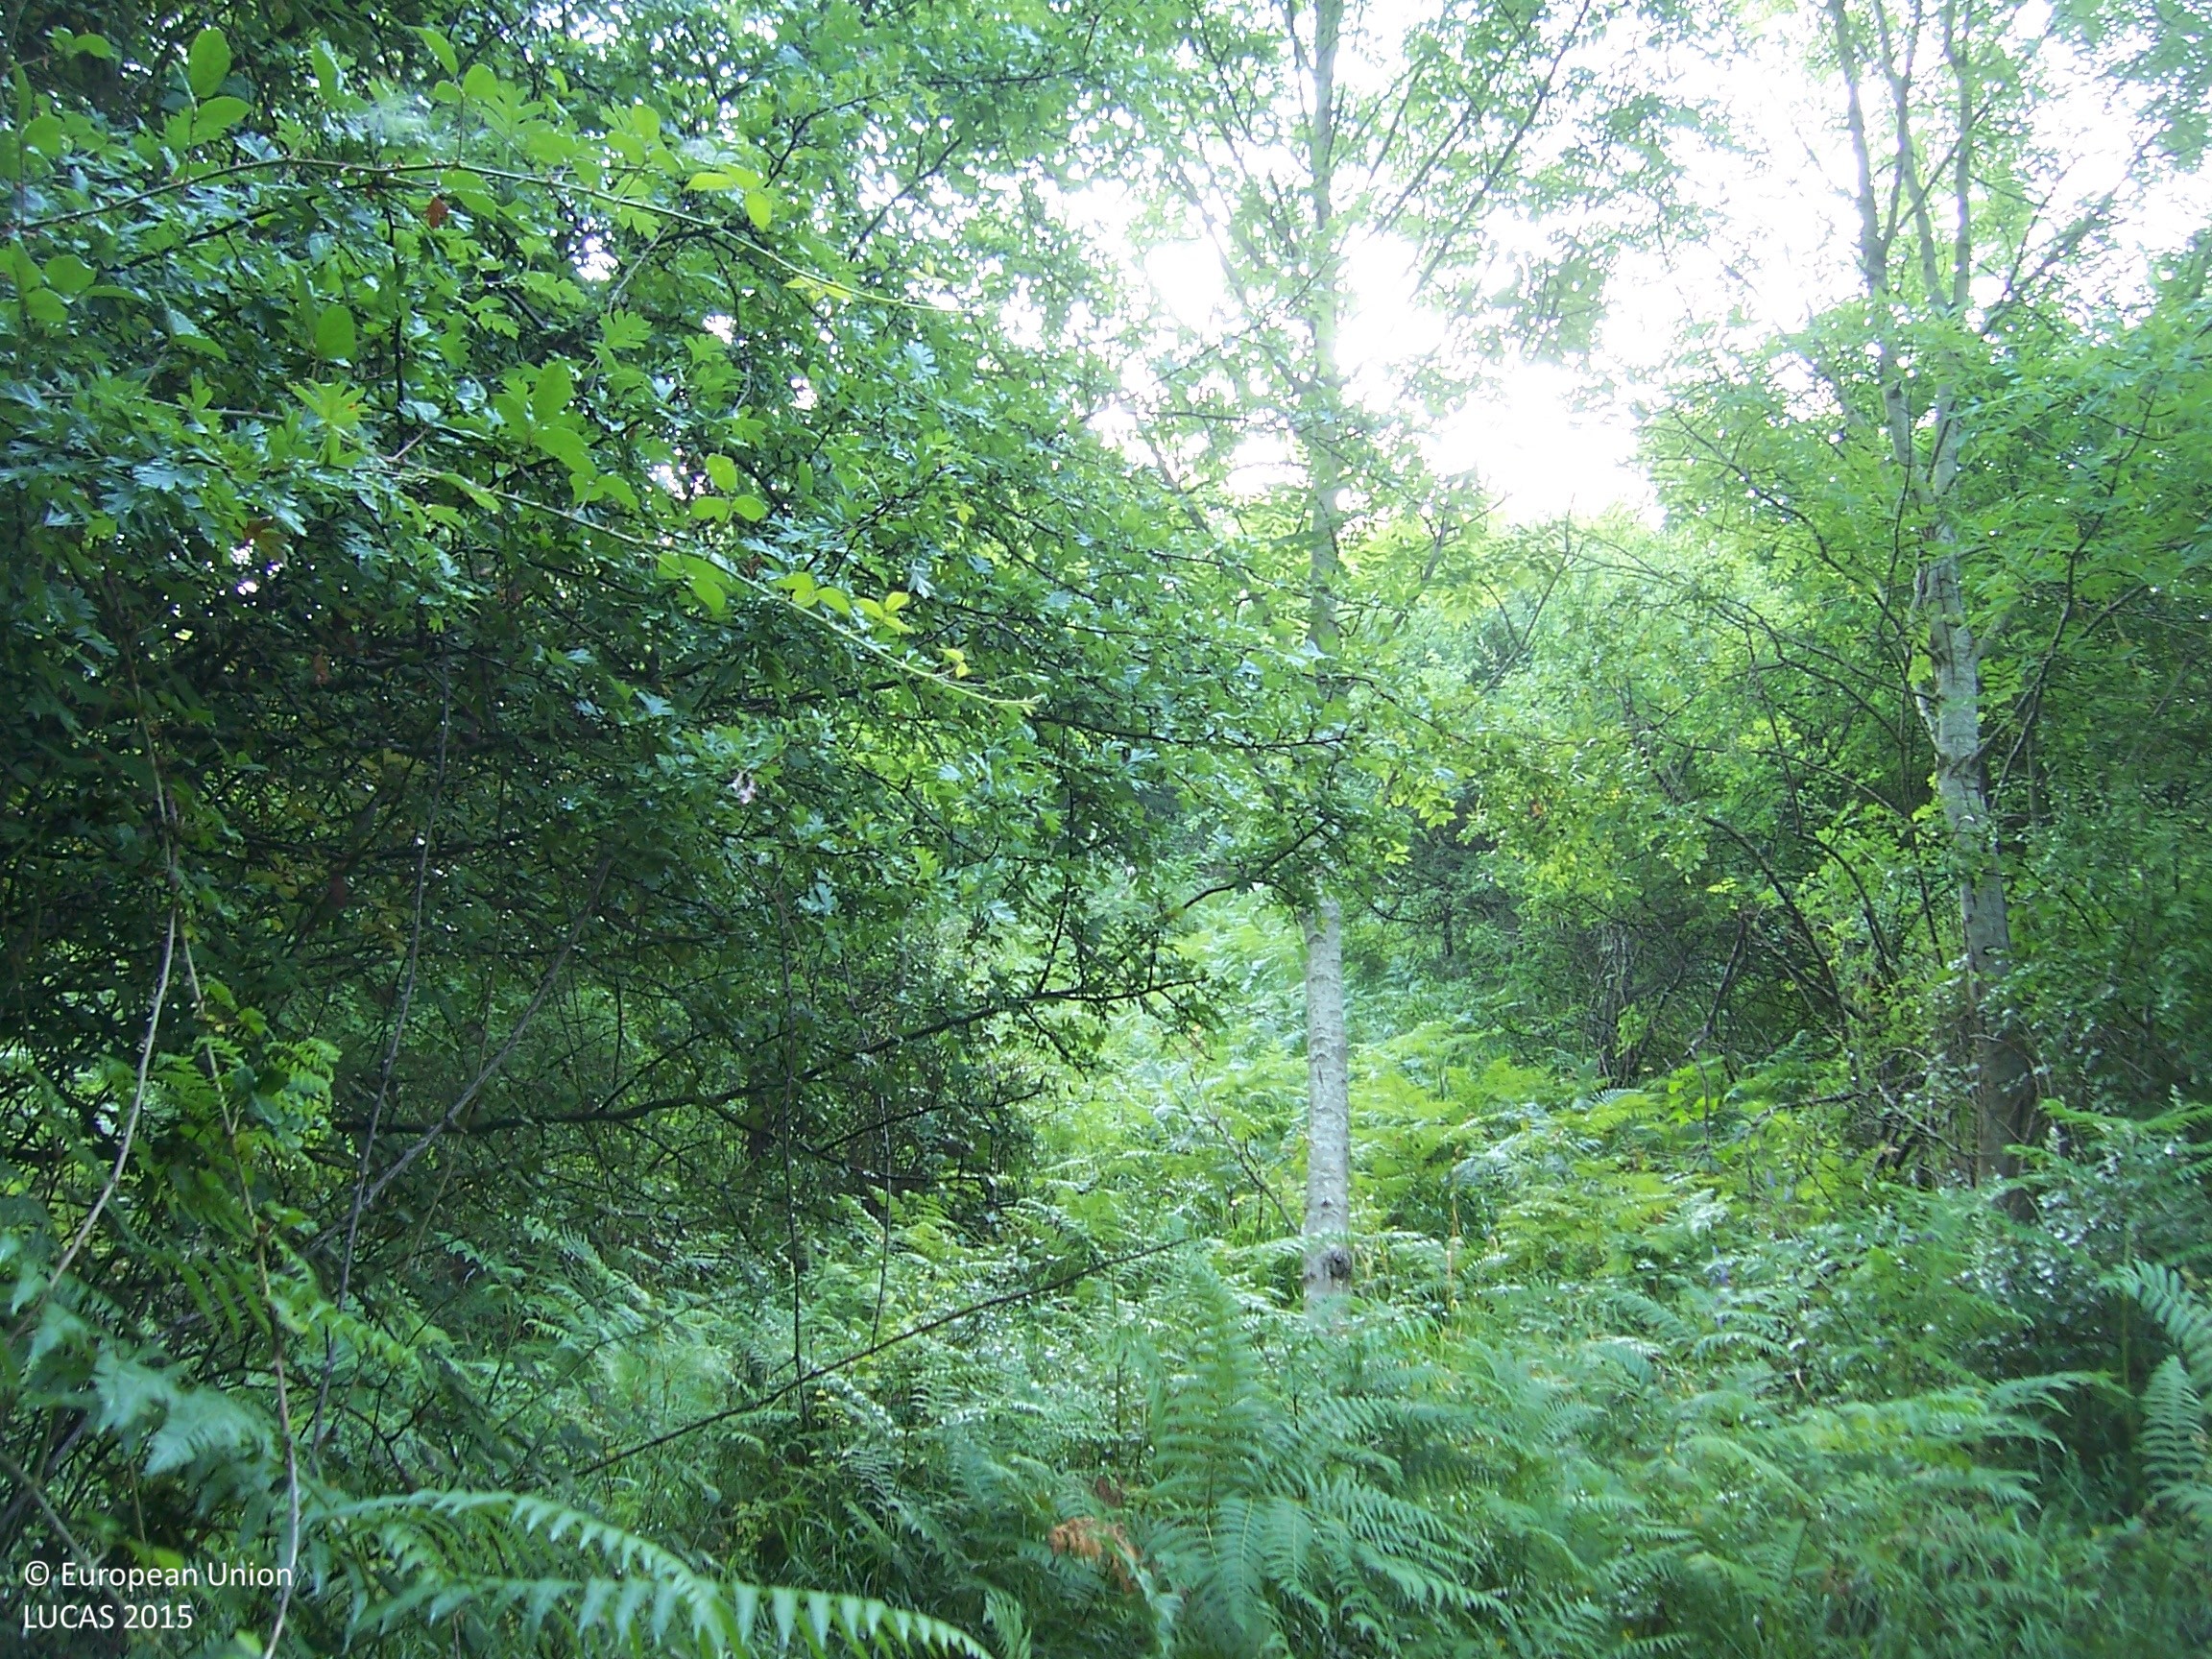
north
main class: Woodland
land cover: Broadleaved woodland
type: floodplain forest
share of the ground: > 75 %
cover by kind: broadleaved forest trees 100 %
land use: Semi-natural and natural areas not in use
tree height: > 5 m
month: July
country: ES
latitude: 42.9979
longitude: -1.5083
